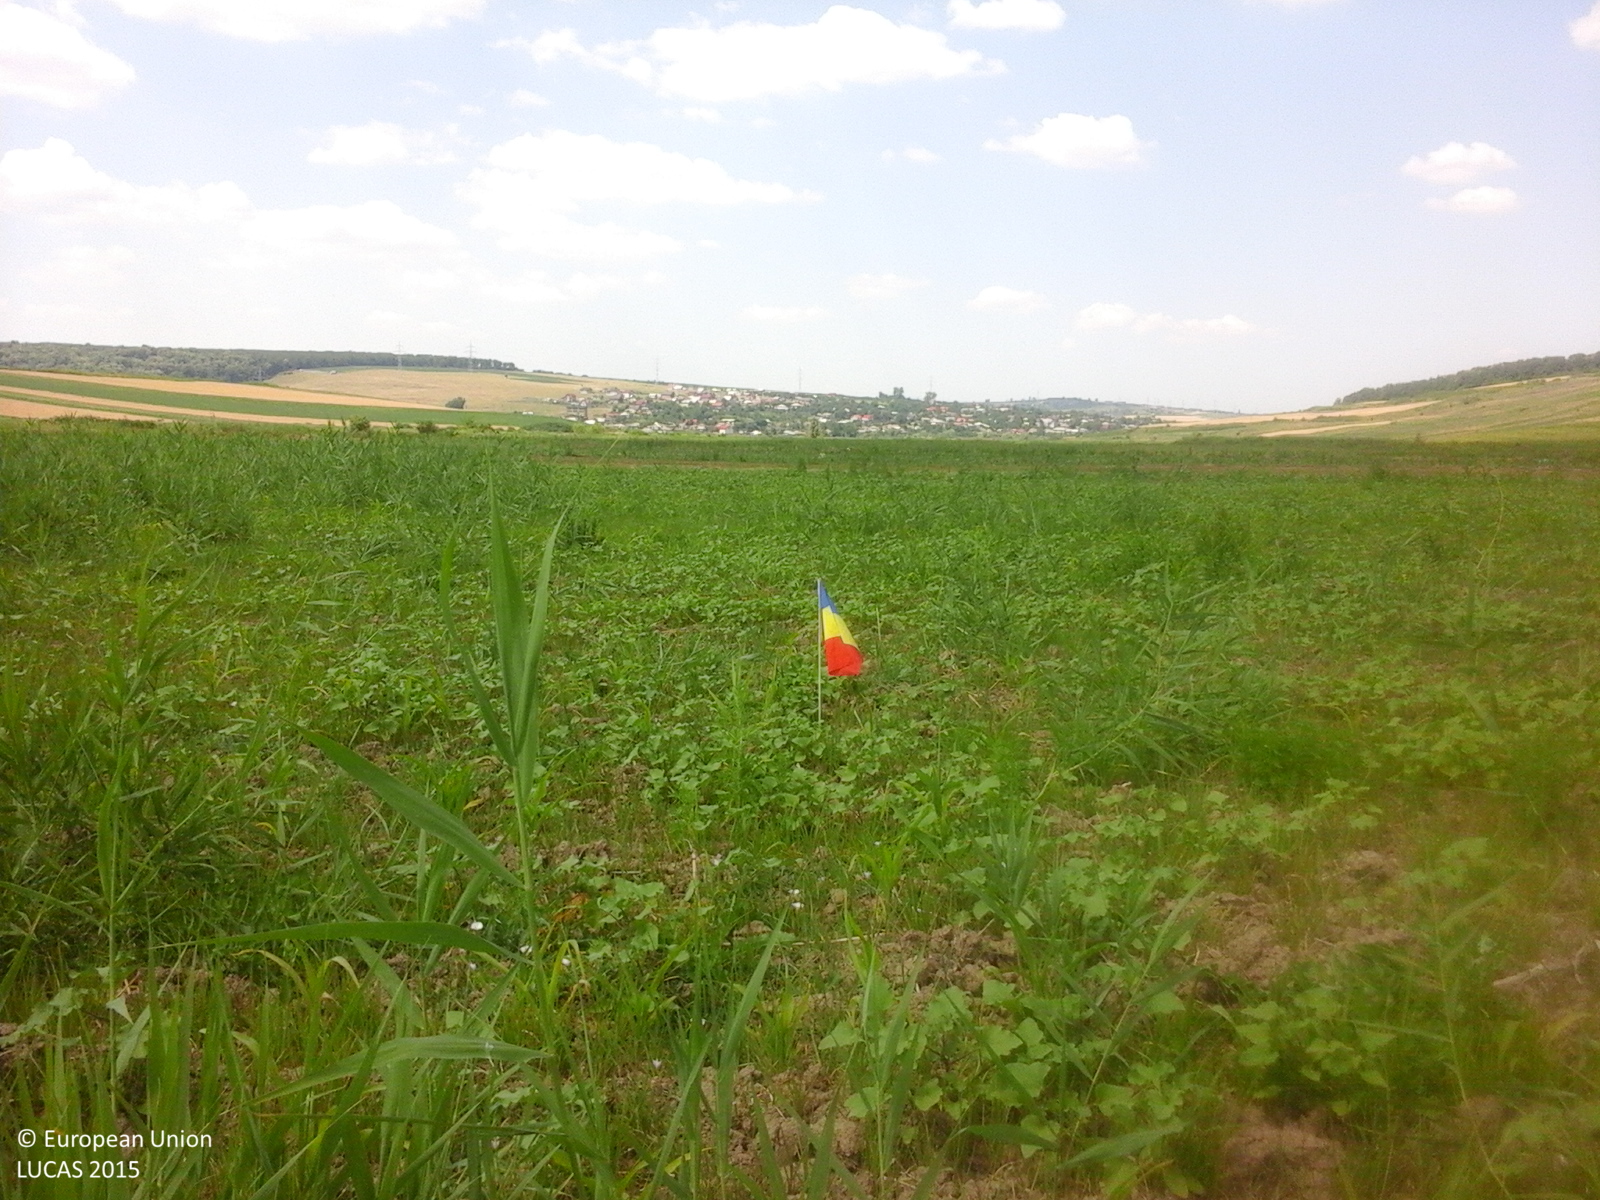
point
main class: Grassland
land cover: Spontaneously vegetated surfaces
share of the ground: > 75 %
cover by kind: herbaceous plants 100 %
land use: Fallow land
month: June
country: RO
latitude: 47.0567
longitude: 27.5606
